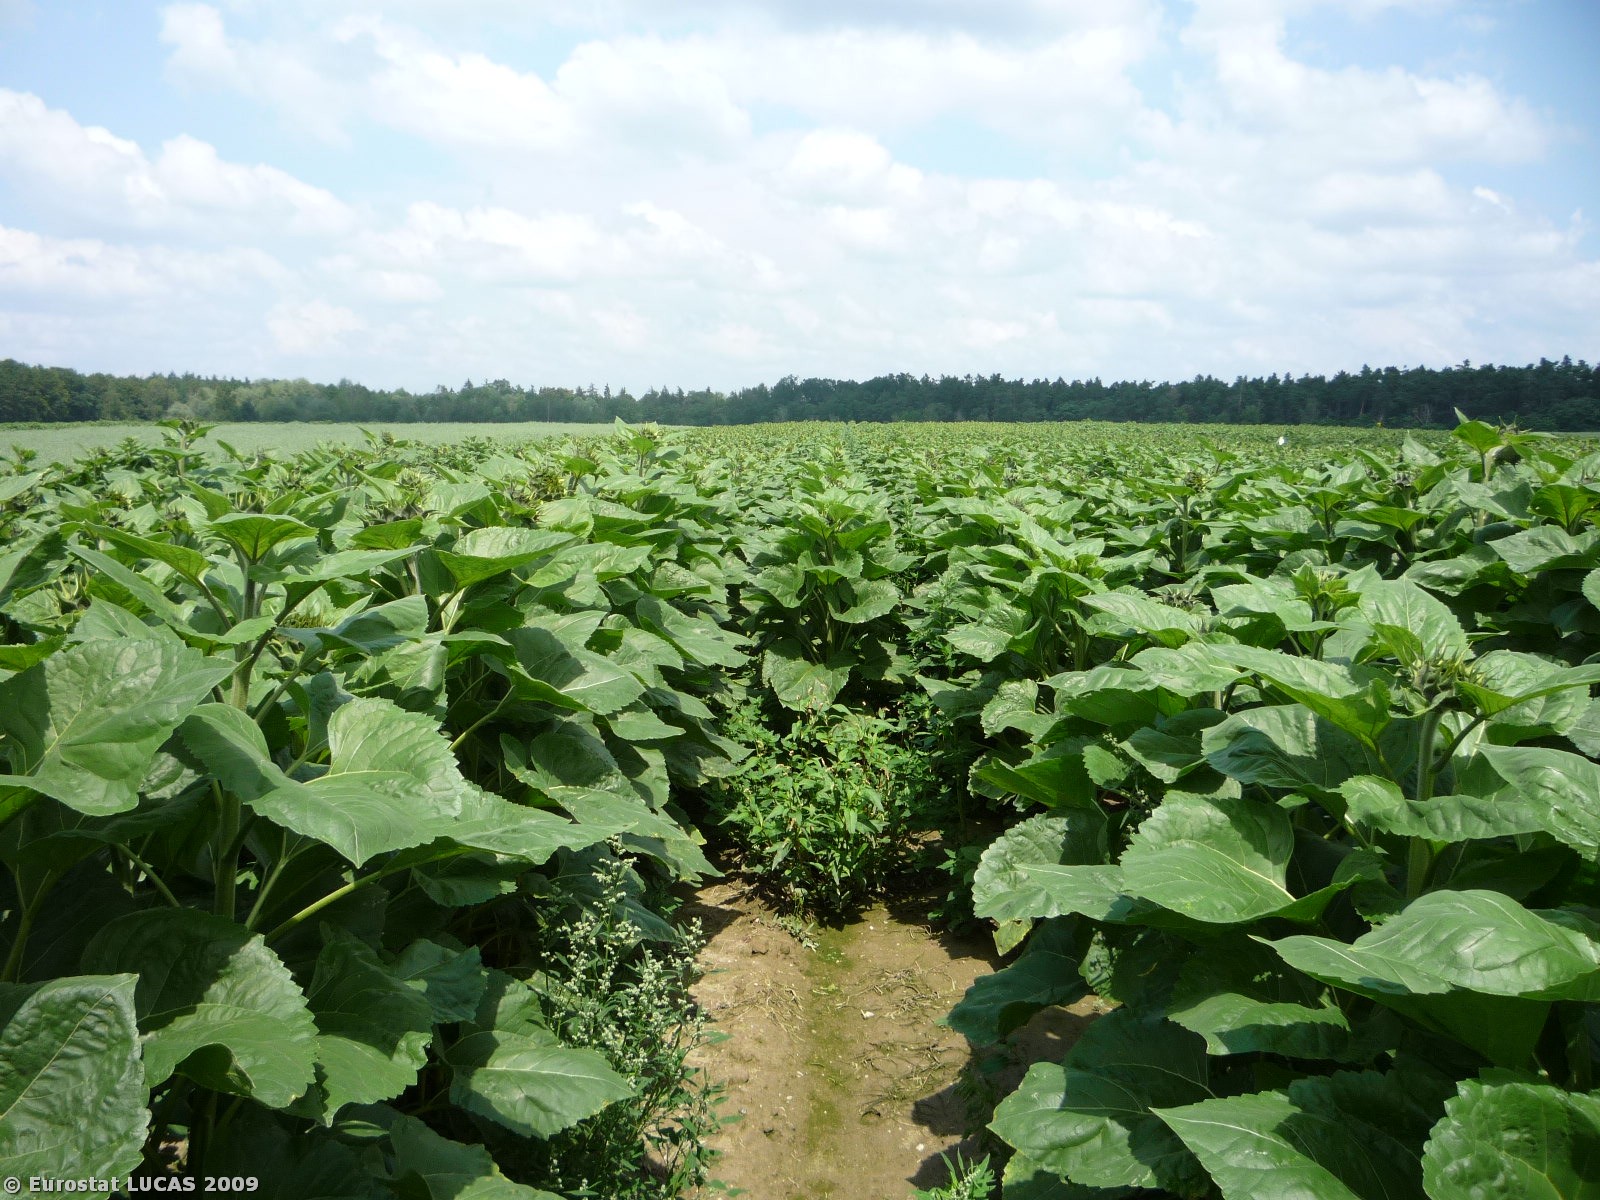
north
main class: Cropland
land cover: Sunflower
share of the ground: > 75 %
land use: Agriculture (excluding fallow land and kitchen gardens)
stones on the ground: < 10 %
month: June
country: CZ
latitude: 50.2902
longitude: 15.0137
